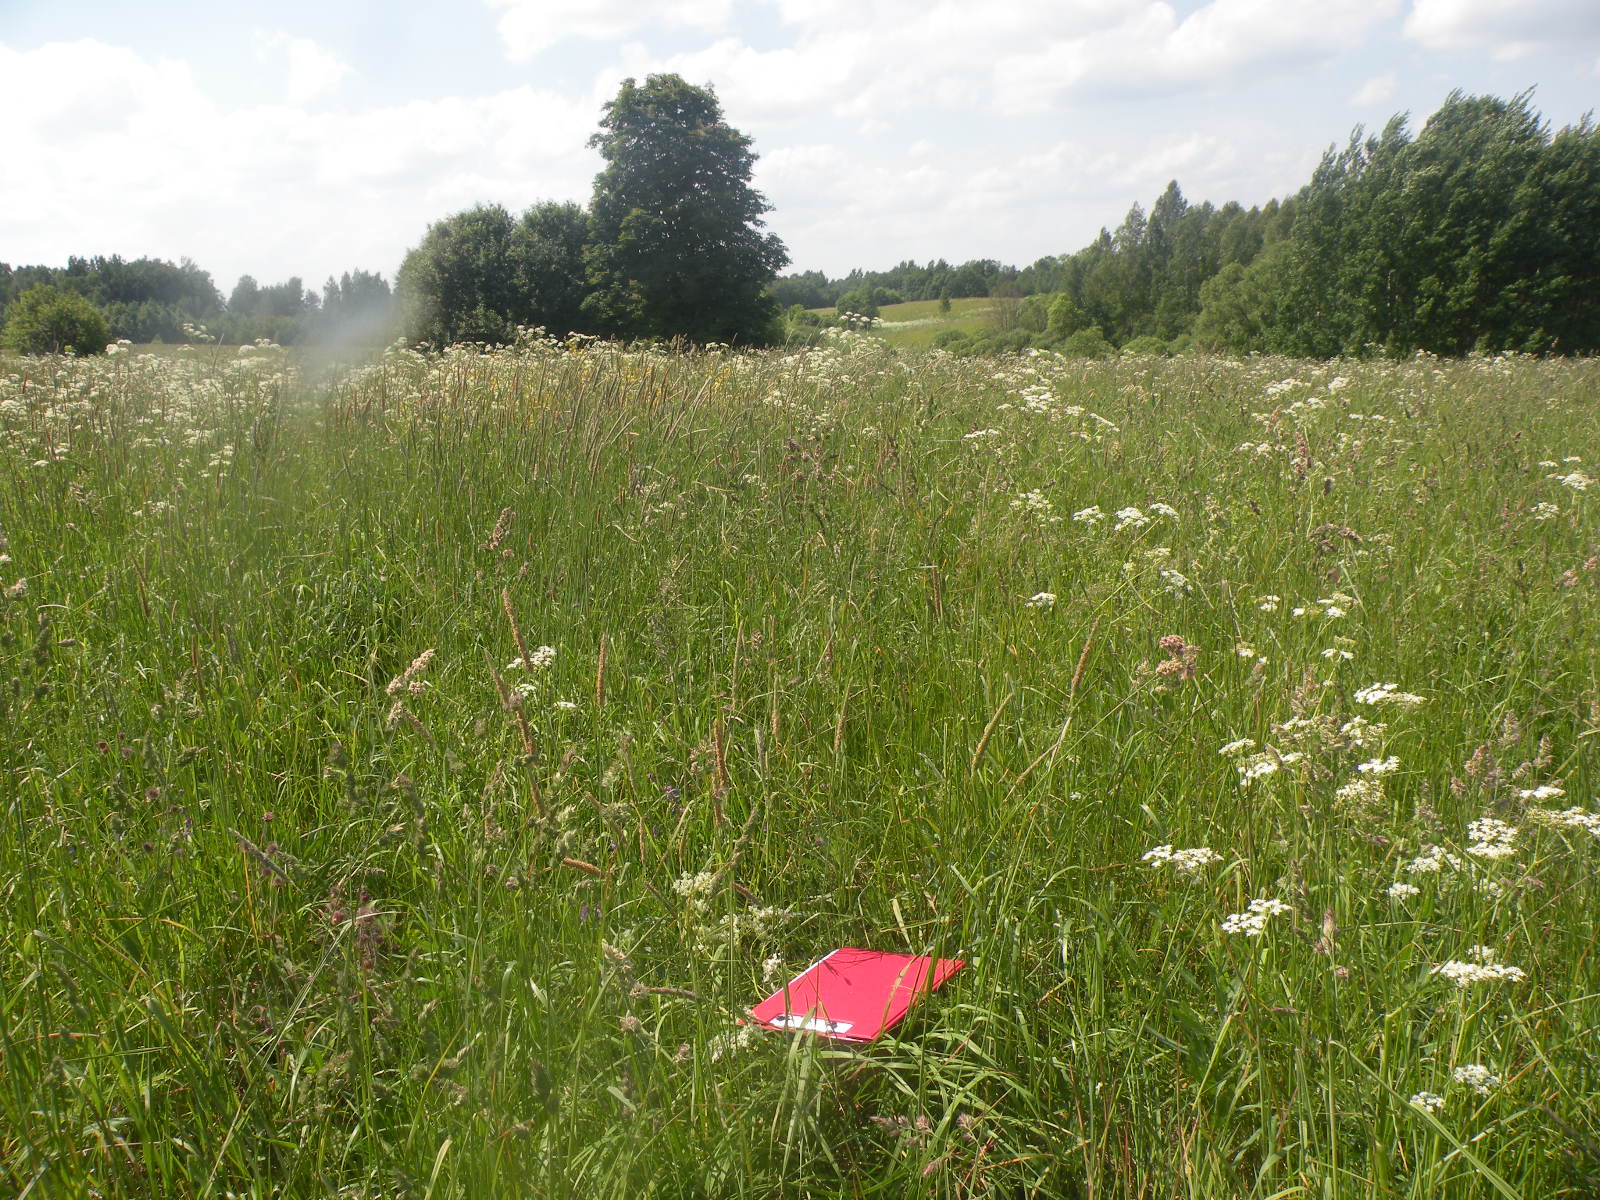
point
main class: Grassland
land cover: Spontaneously vegetated surfaces
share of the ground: > 75 %
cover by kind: herbaceous plants 100 %
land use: Semi-natural and natural areas not in use
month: June
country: LV
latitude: 56.1302
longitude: 26.8442
